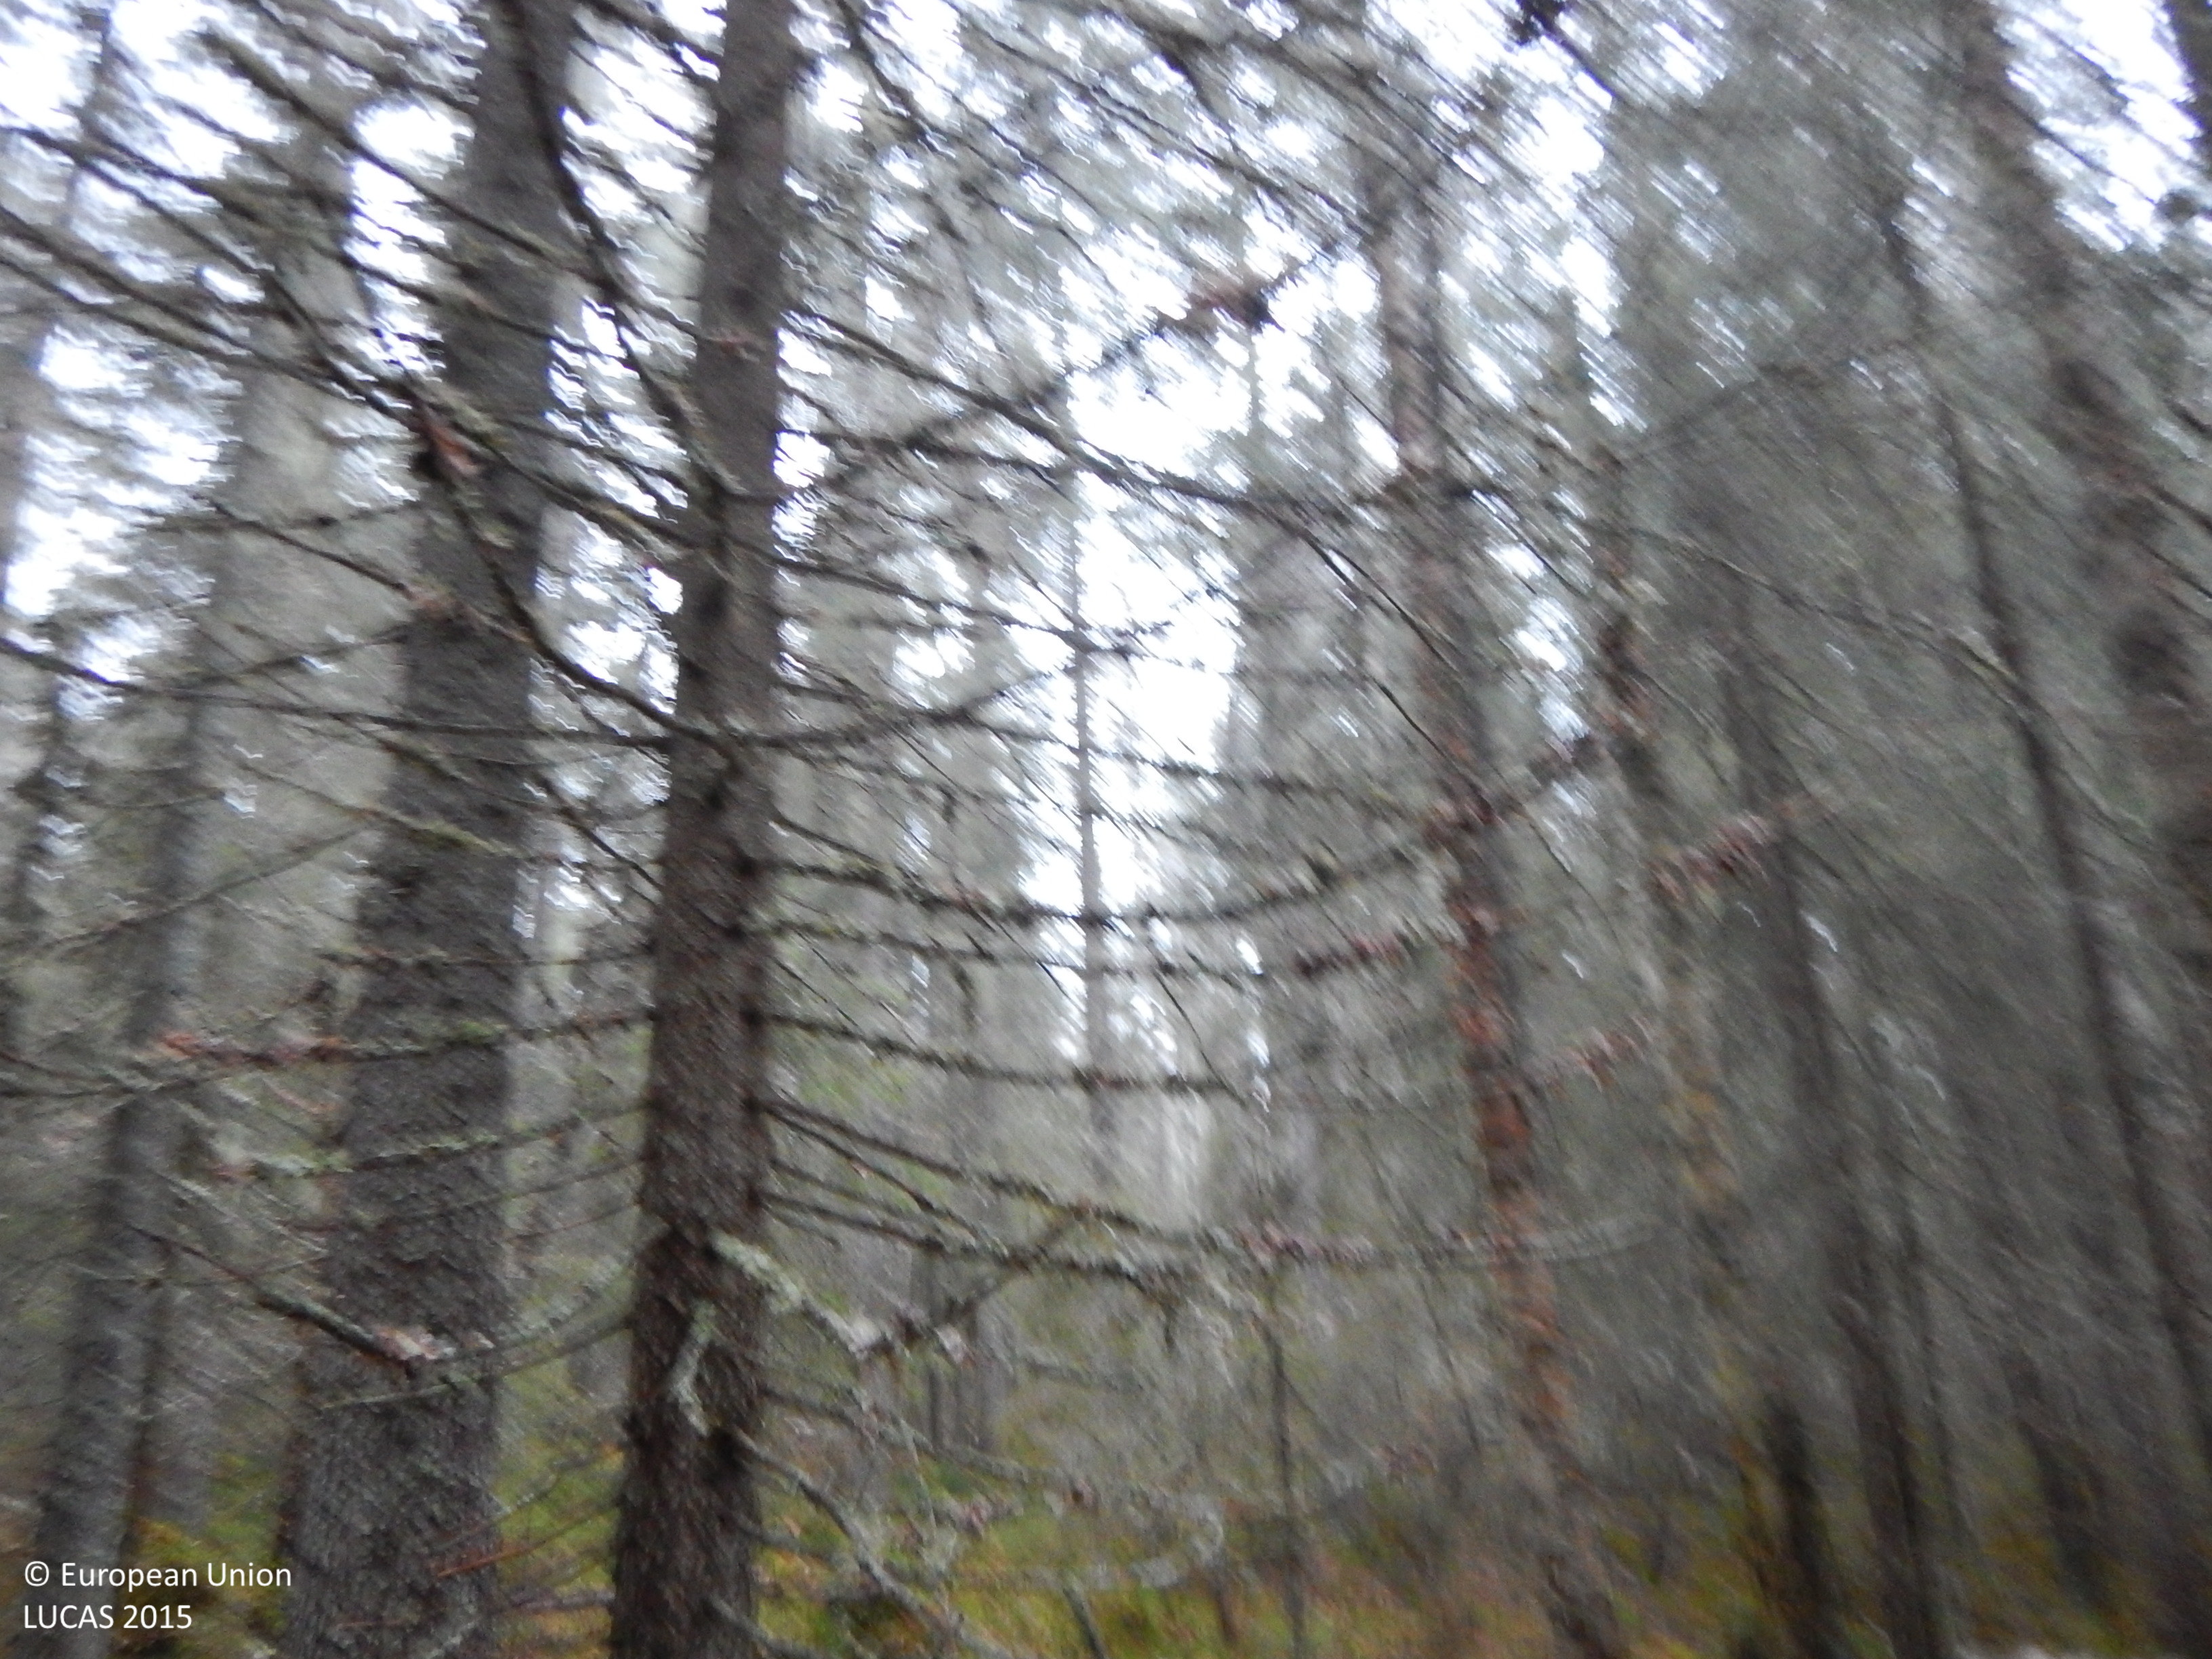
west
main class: Woodland
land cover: Spruce dominated mixed woodland
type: boreal forest
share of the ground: > 75 %
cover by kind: coniferous forest trees 60 %, broadleaved forest trees 20 %, shrubs 10 %, herbaceous plants 5 %, lichens and mosses 5 %
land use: Forestry
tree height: > 5 m
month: November
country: SE
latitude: 65.1402
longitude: 20.5665
